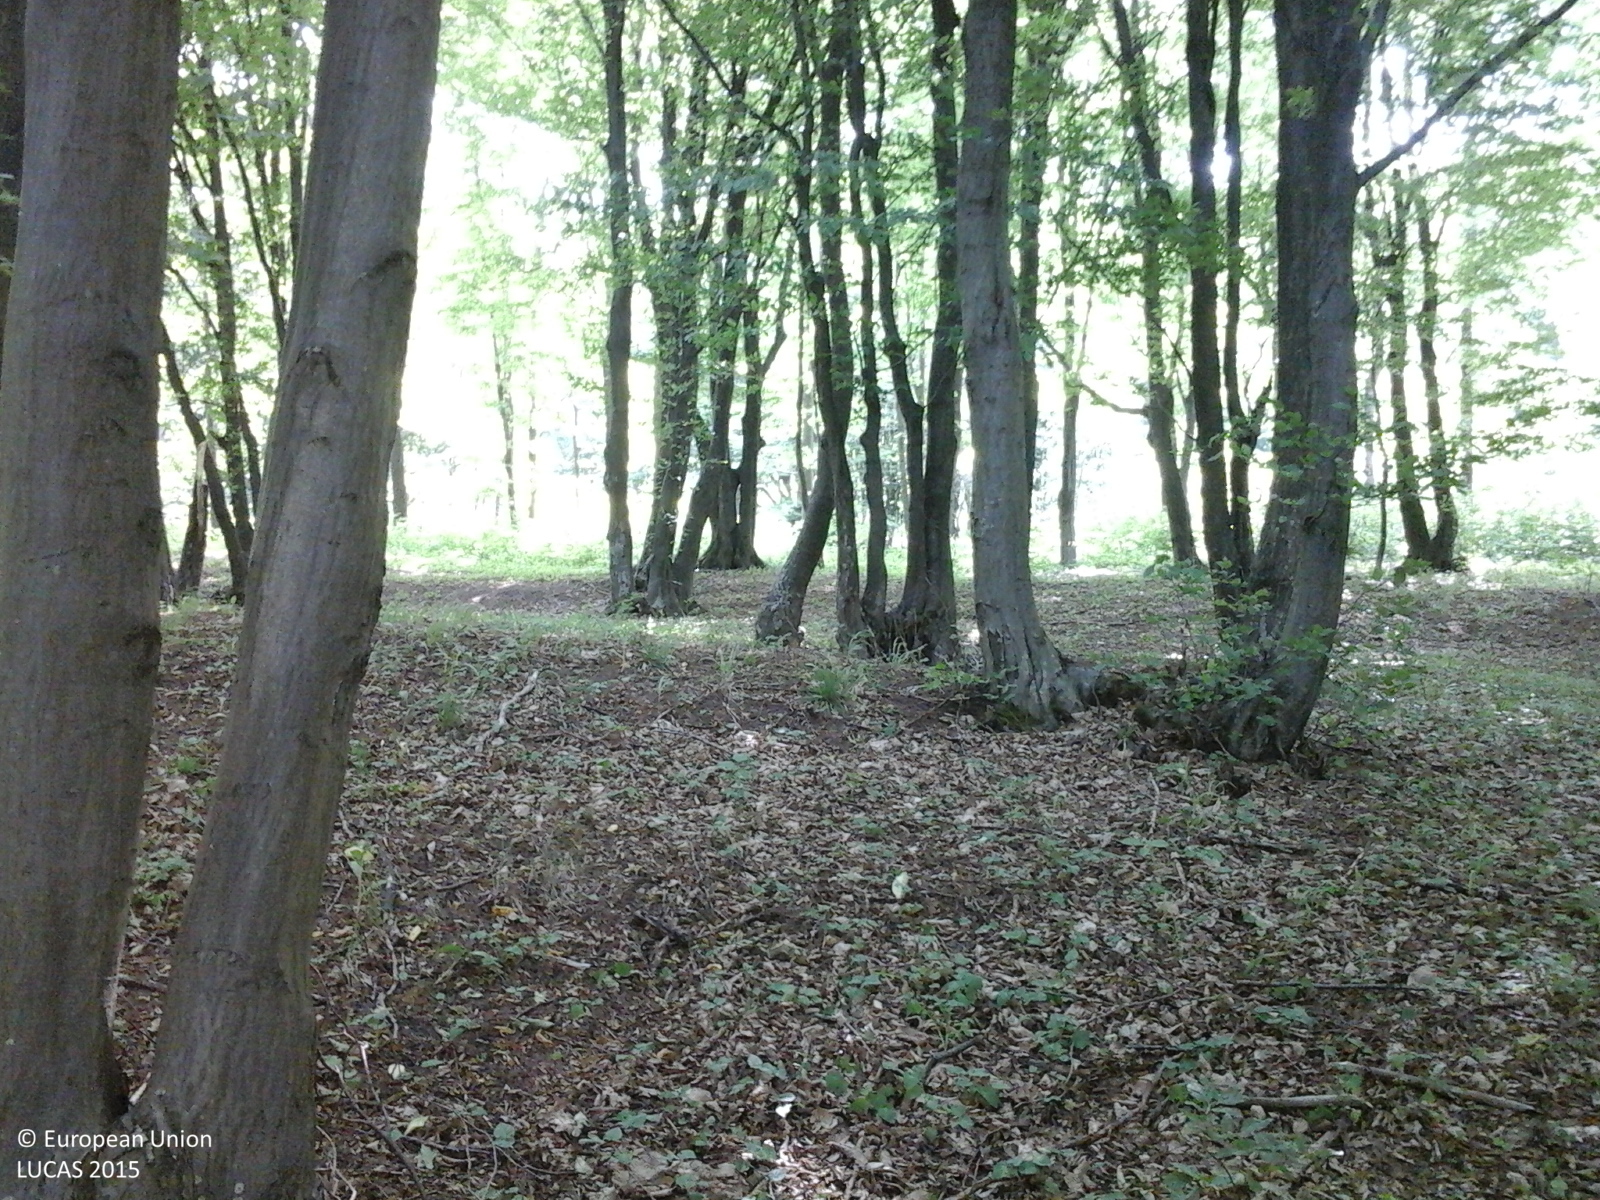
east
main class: Woodland
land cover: Broadleaved woodland
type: beech forest
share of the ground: > 75 %
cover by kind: broadleaved forest trees 100 %
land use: Forestry
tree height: > 5 m
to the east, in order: Broadleaved woodland; Tracks; Broadleaved woodland; Paved roads, cycling and walking lanes; Broadleaved woodland; Maize; Other fresh vegetables
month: June
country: RO
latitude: 47.4030
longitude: 26.7789
